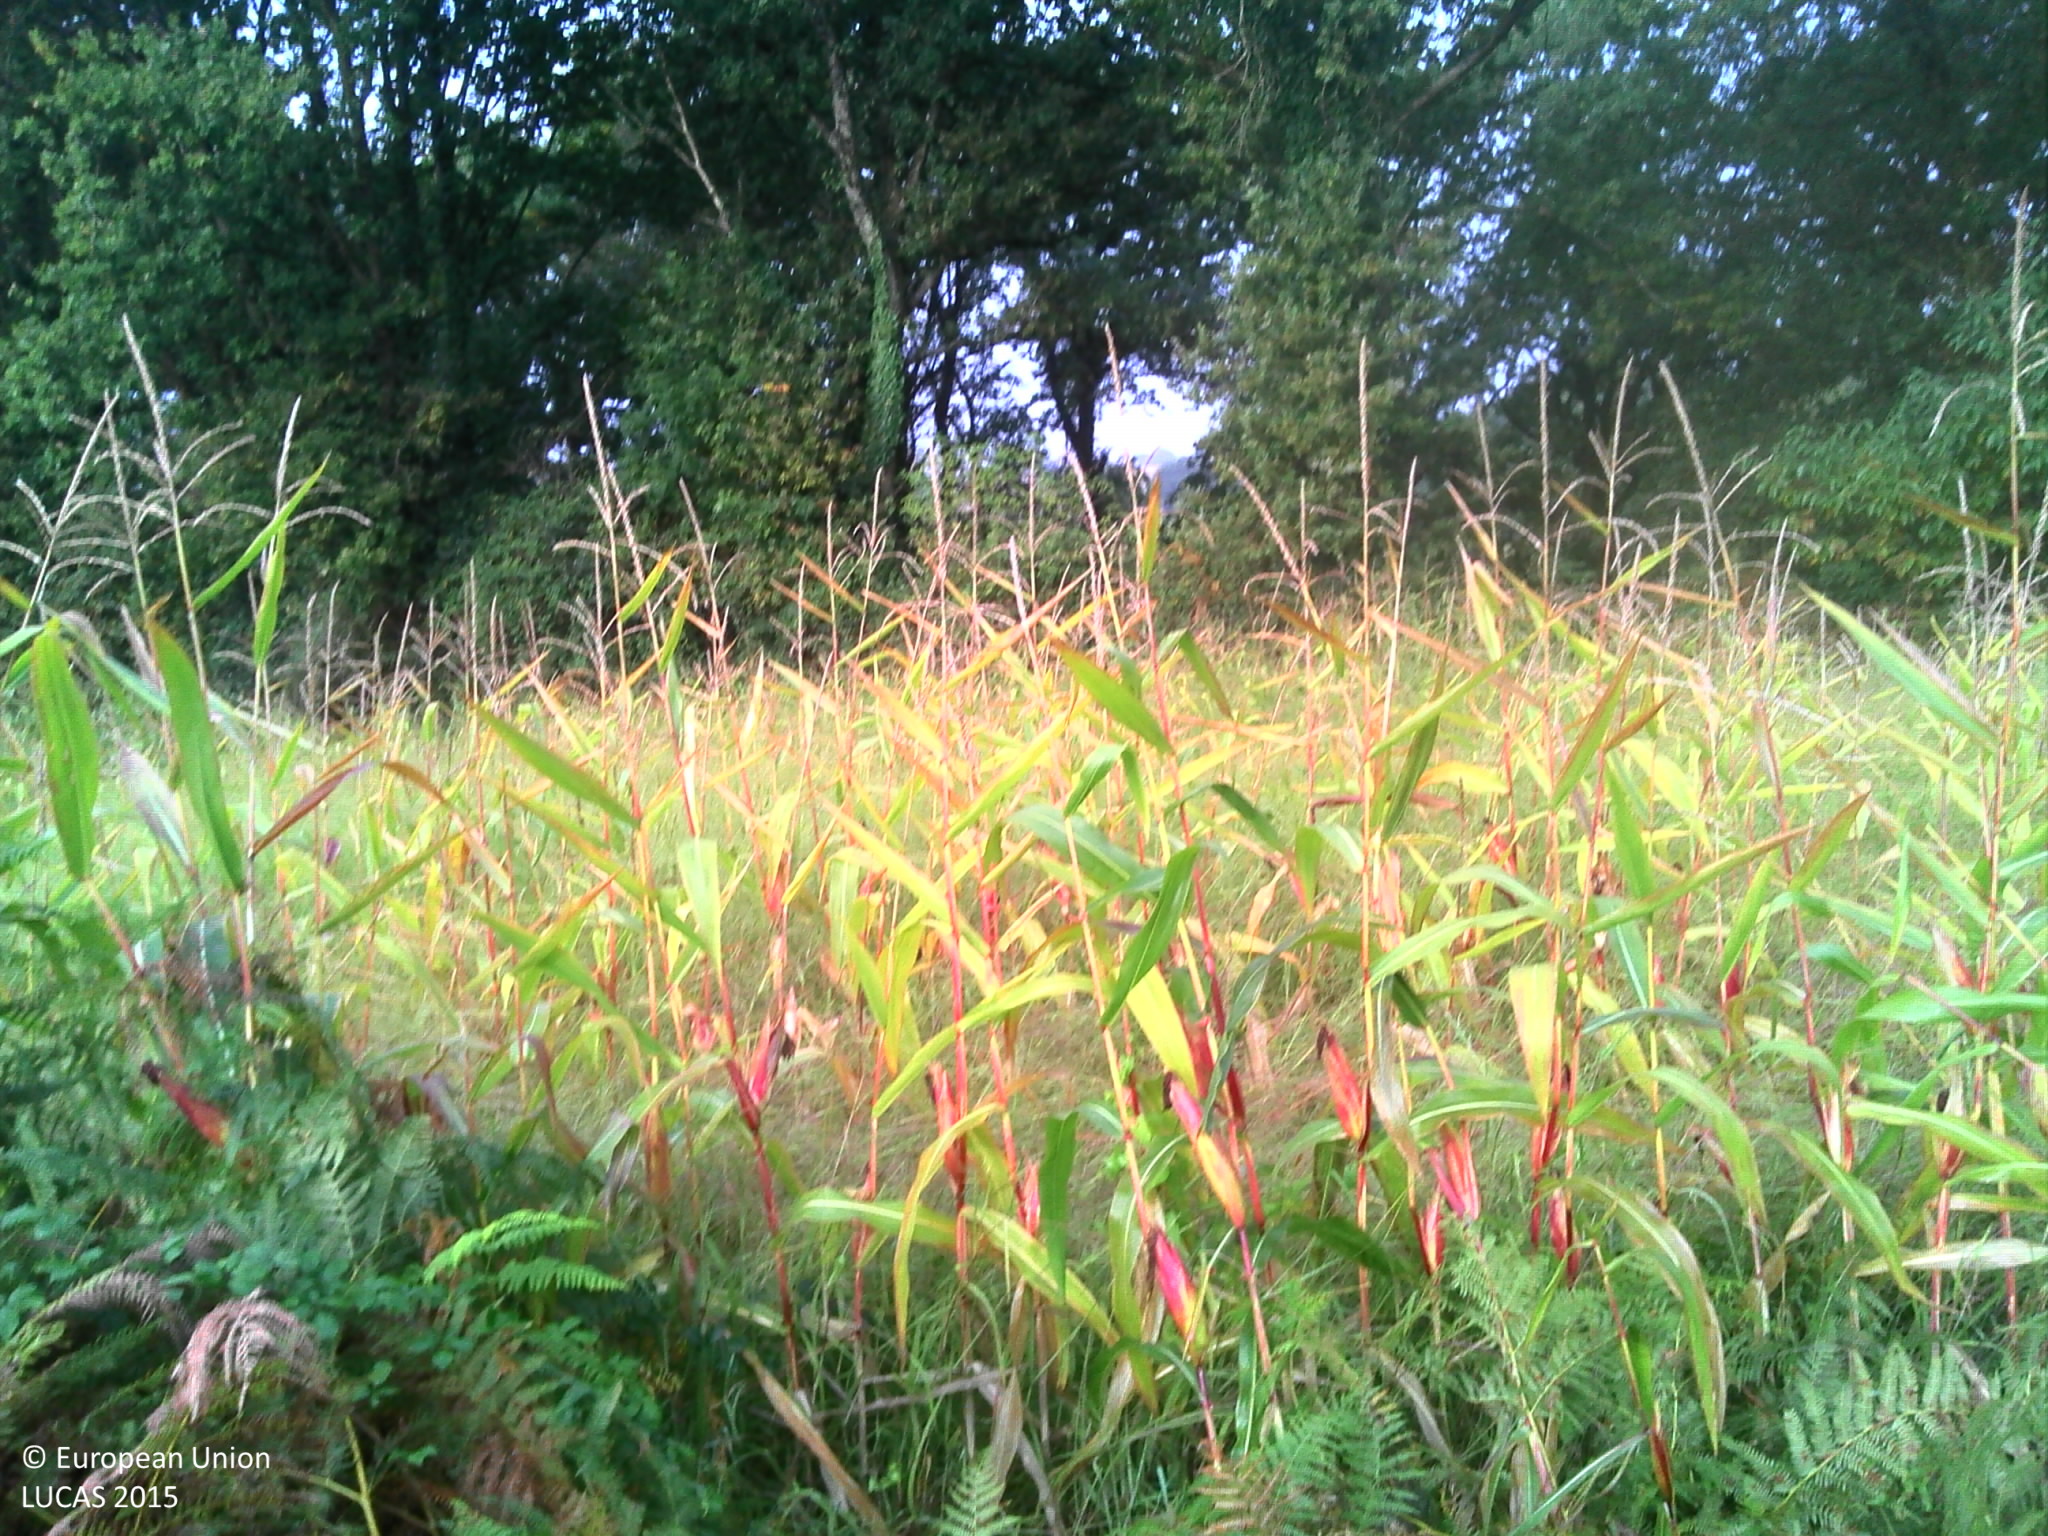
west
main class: Cropland
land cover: Maize
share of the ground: > 75 %
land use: Agriculture (excluding fallow land and kitchen gardens)
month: October
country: FR
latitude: 47.6246
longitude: -2.2831
